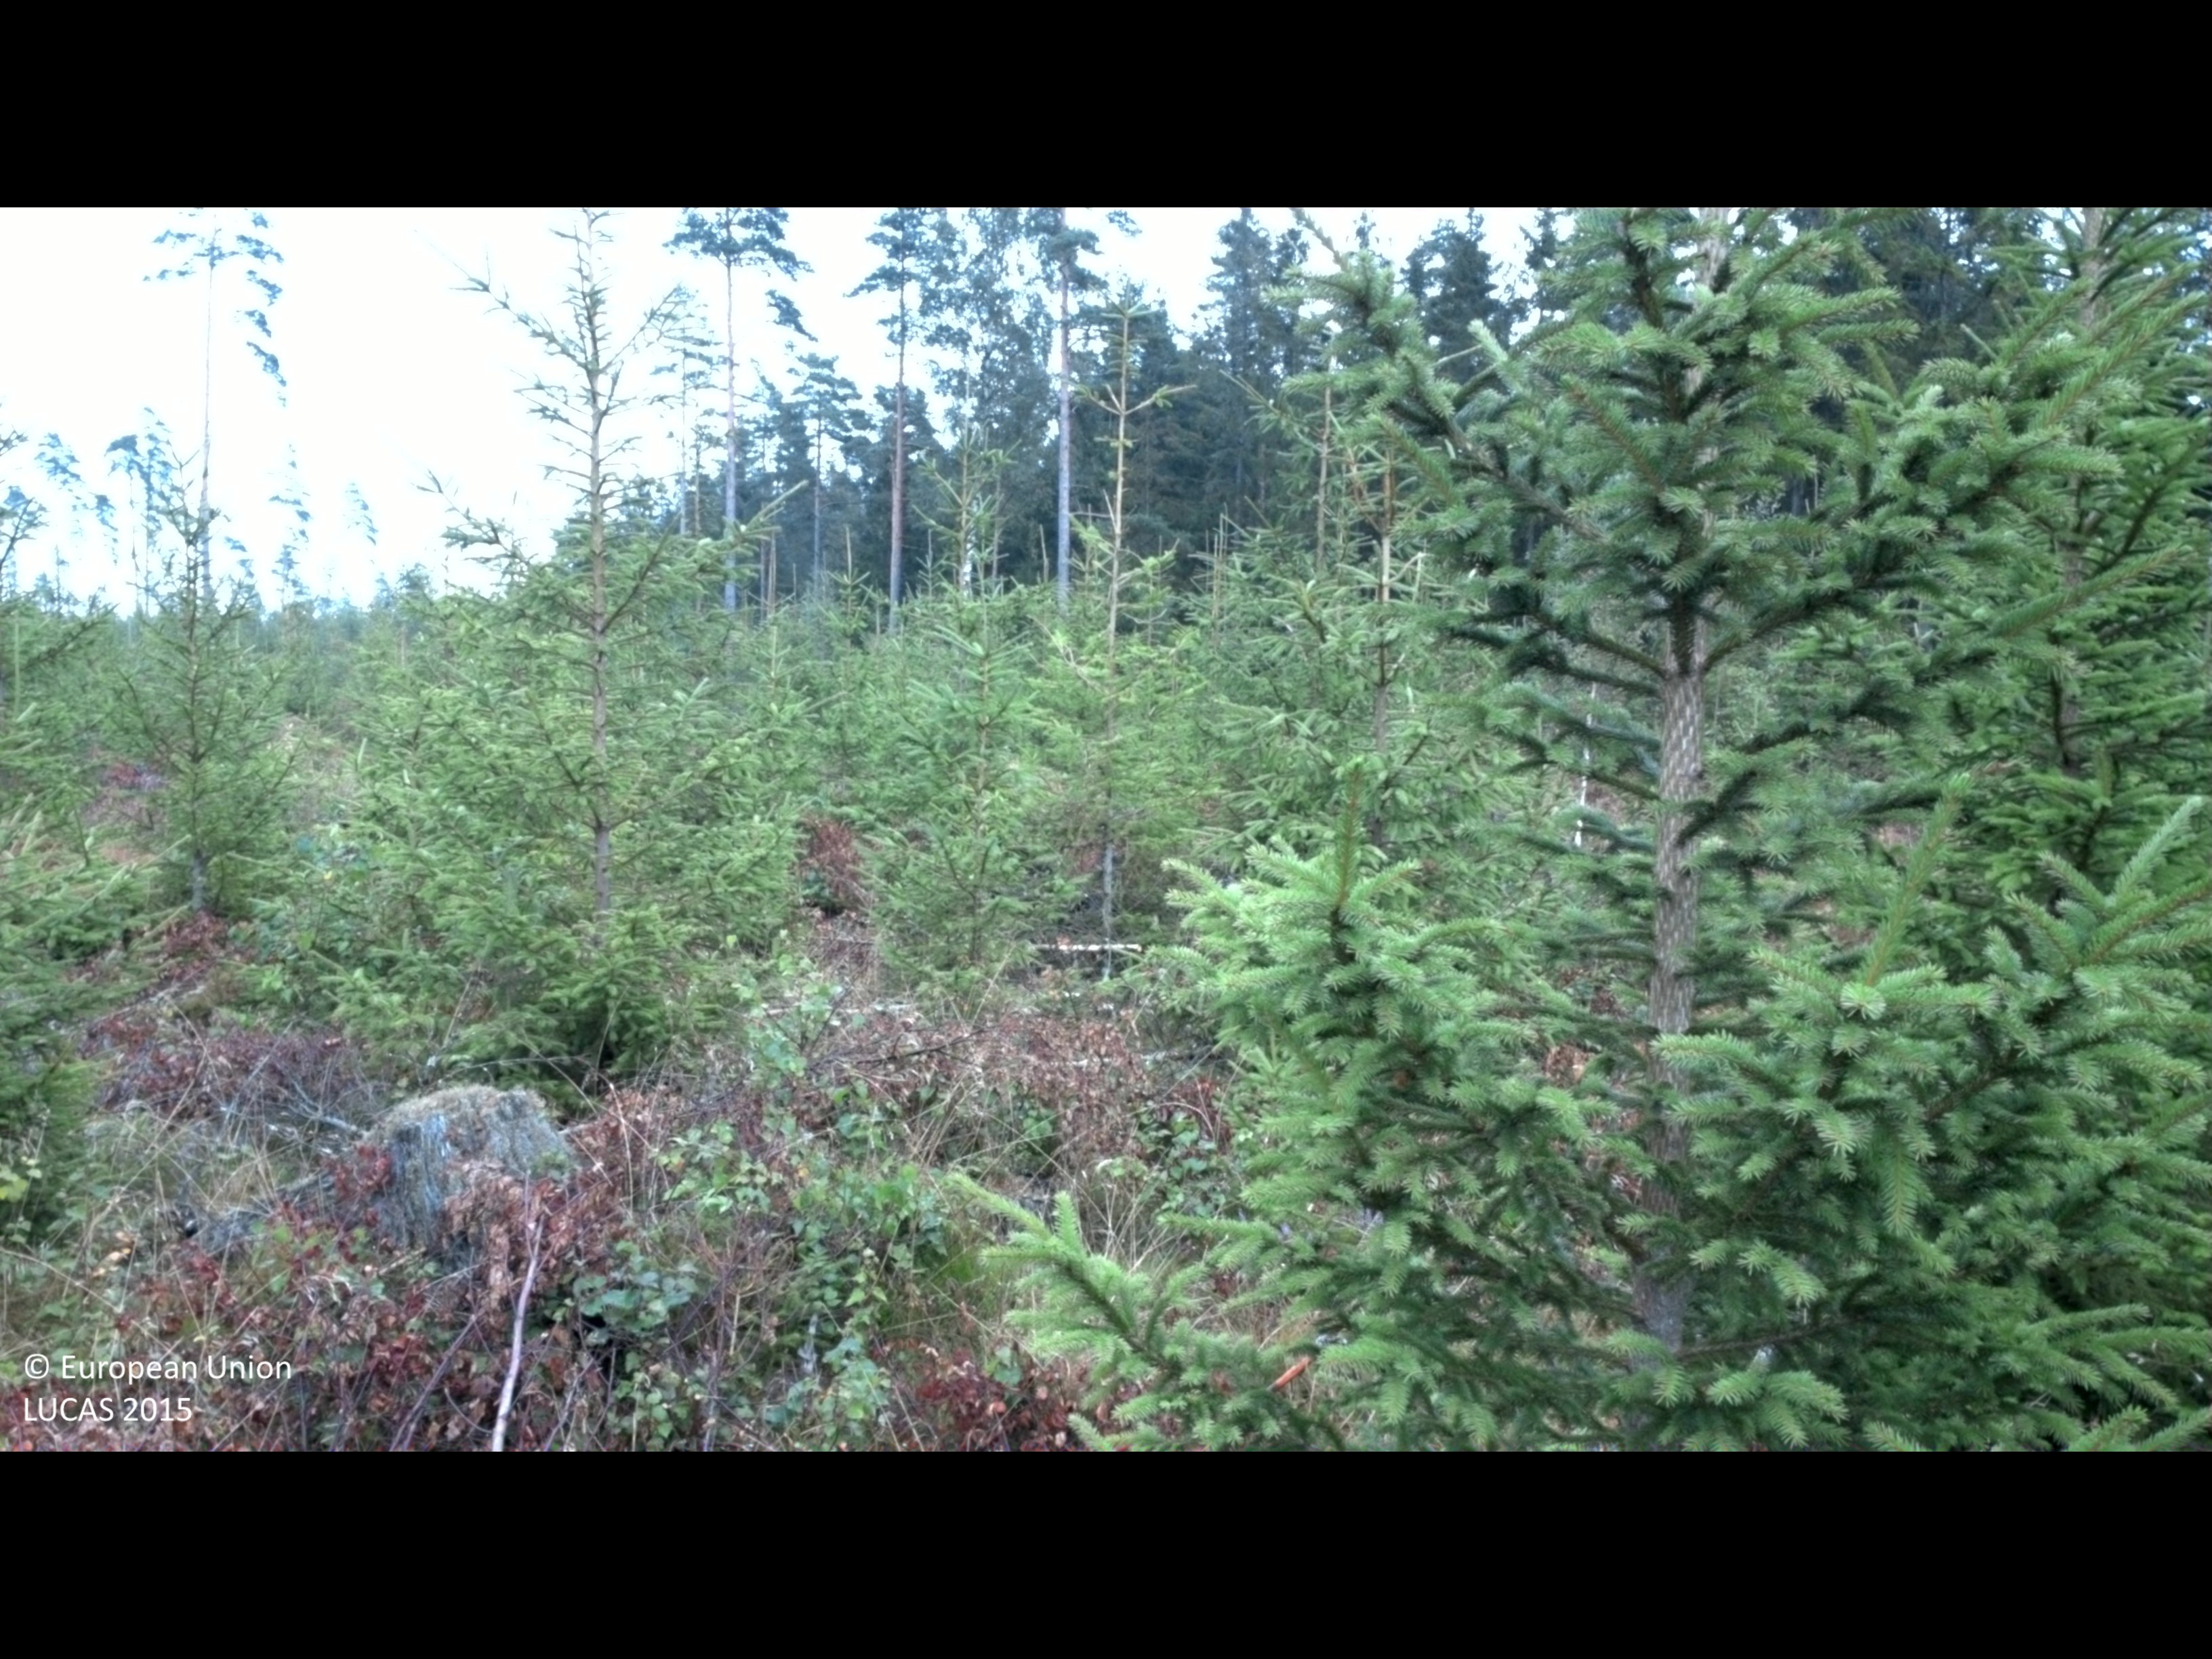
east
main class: Woodland
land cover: Spruce dominated coniferous woodland
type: boreal forest
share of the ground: 50 - 75 %
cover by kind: coniferous forest trees 60 %, shrubs 20 %, herbaceous plants 15 %, broadleaved forest trees 5 %
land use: Forestry
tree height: < 5 m
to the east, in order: Spruce dominated coniferous woodland; Pine dominated mixed woodland; Paved roads, cycling and walking lanes; Spruce dominated coniferous woodland
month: August
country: SE
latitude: 56.9216
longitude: 13.2000
